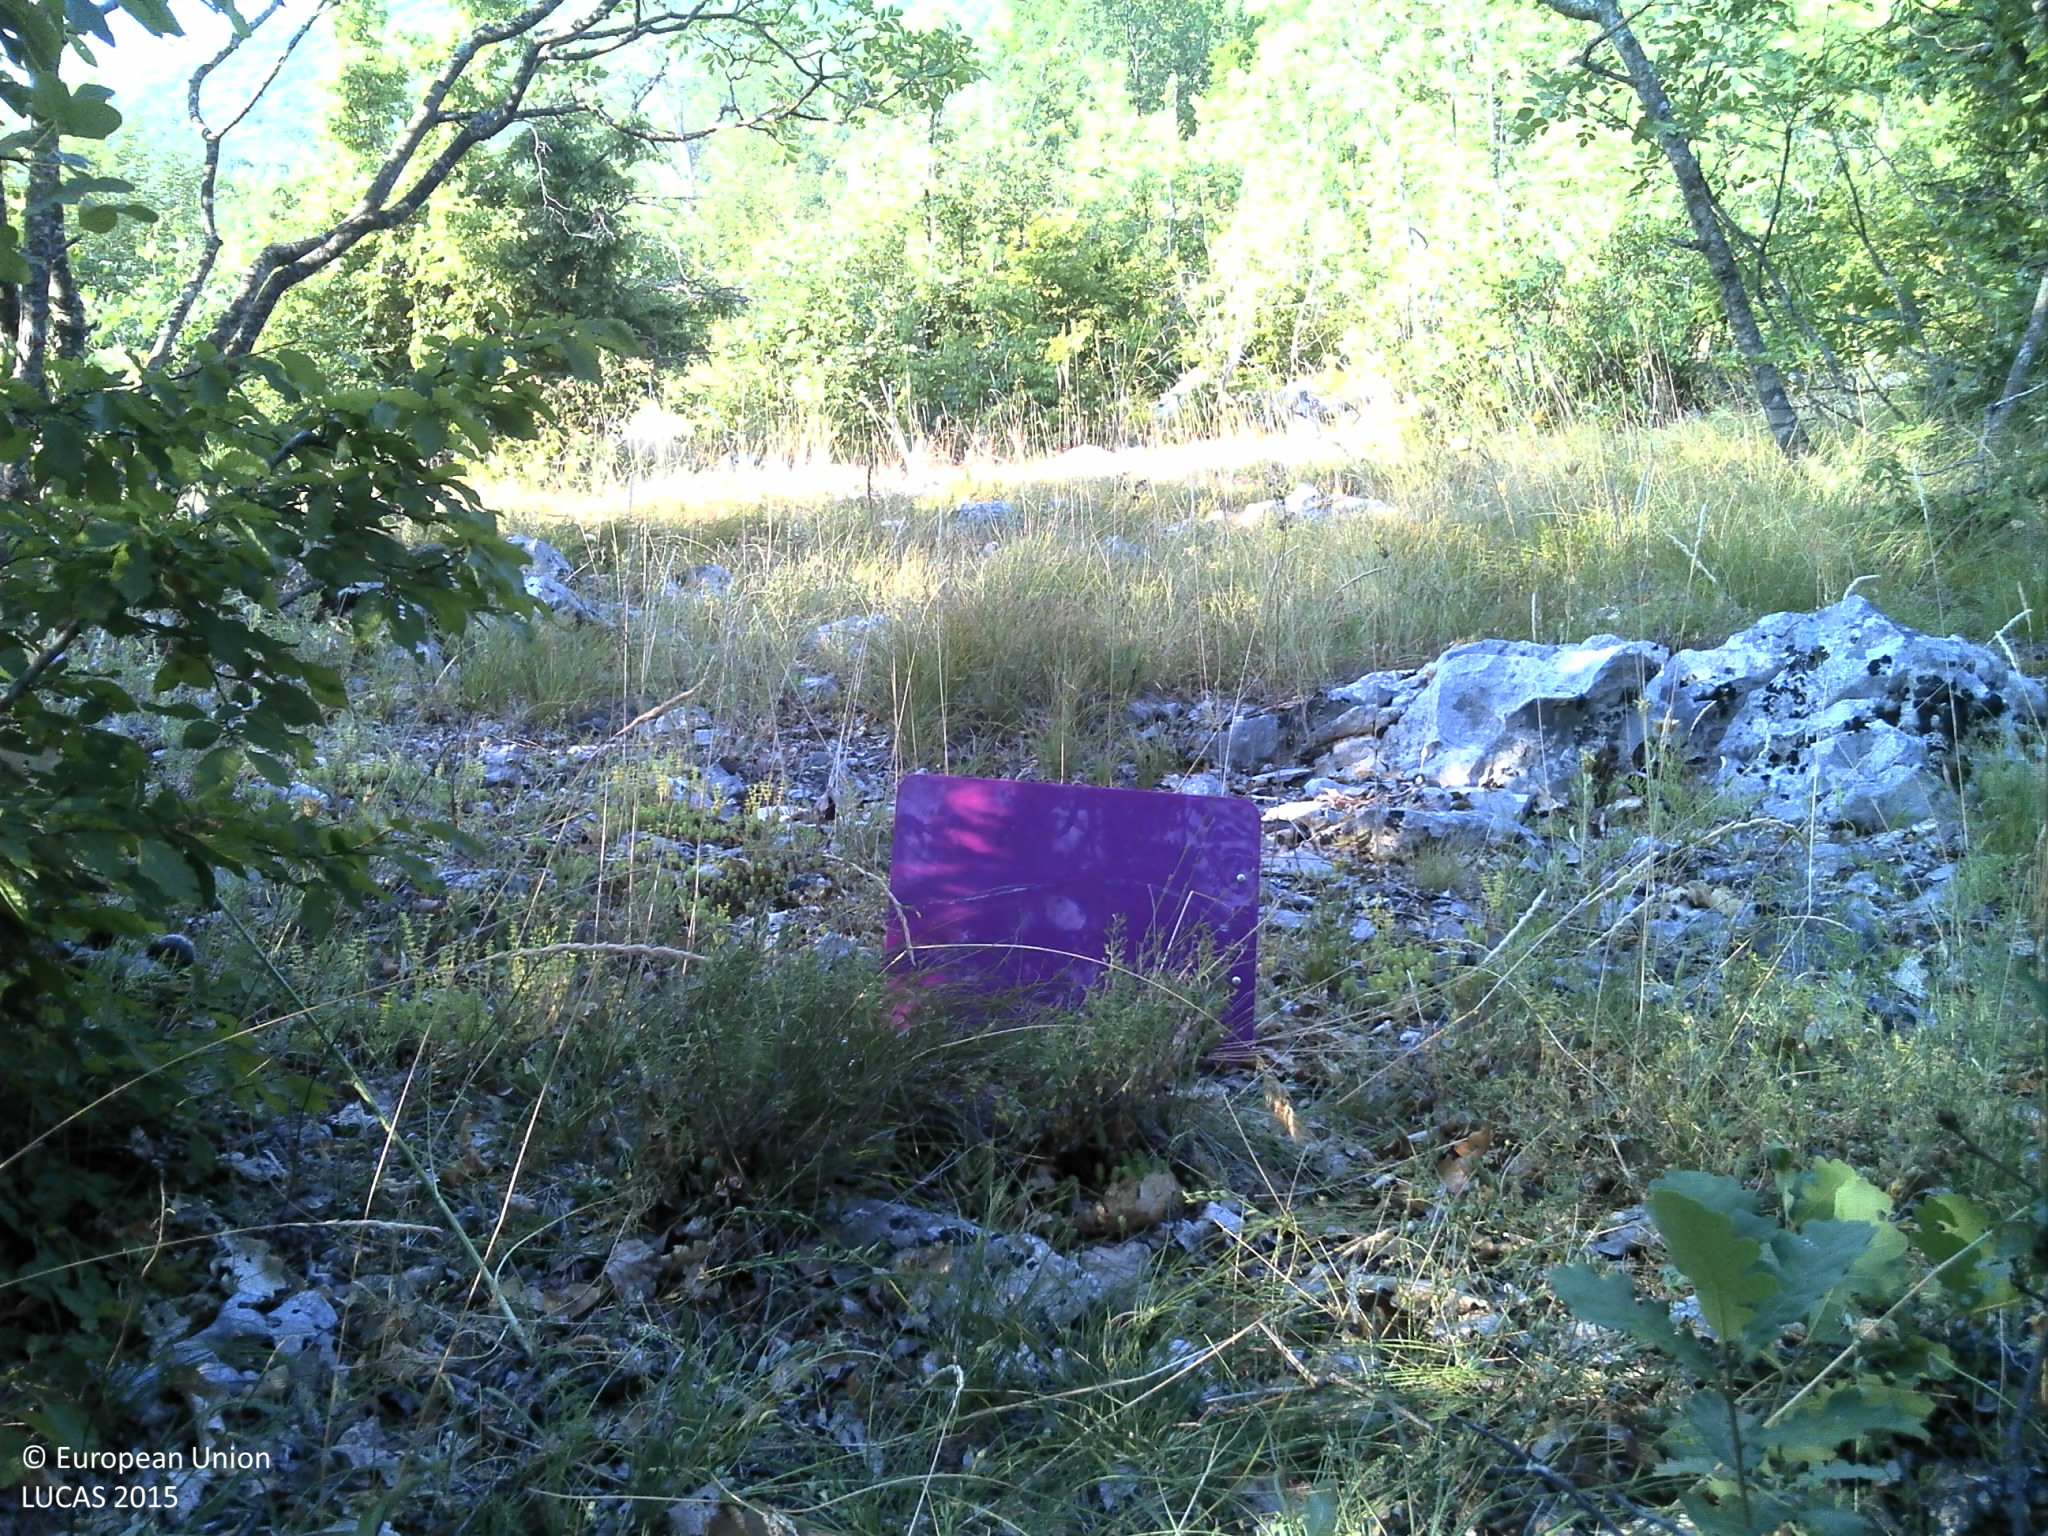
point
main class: Woodland
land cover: Broadleaved woodland
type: thermophilous deciduous forest
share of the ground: 50 - 75 %
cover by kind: broadleaved forest trees 60 %, herbaceous plants 20 %, shrubs 15 %, consolidated bare surface 5 %
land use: Semi-natural and natural areas not in use
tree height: > 5 m
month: July
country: HR
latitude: 43.3658
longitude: 17.0869
